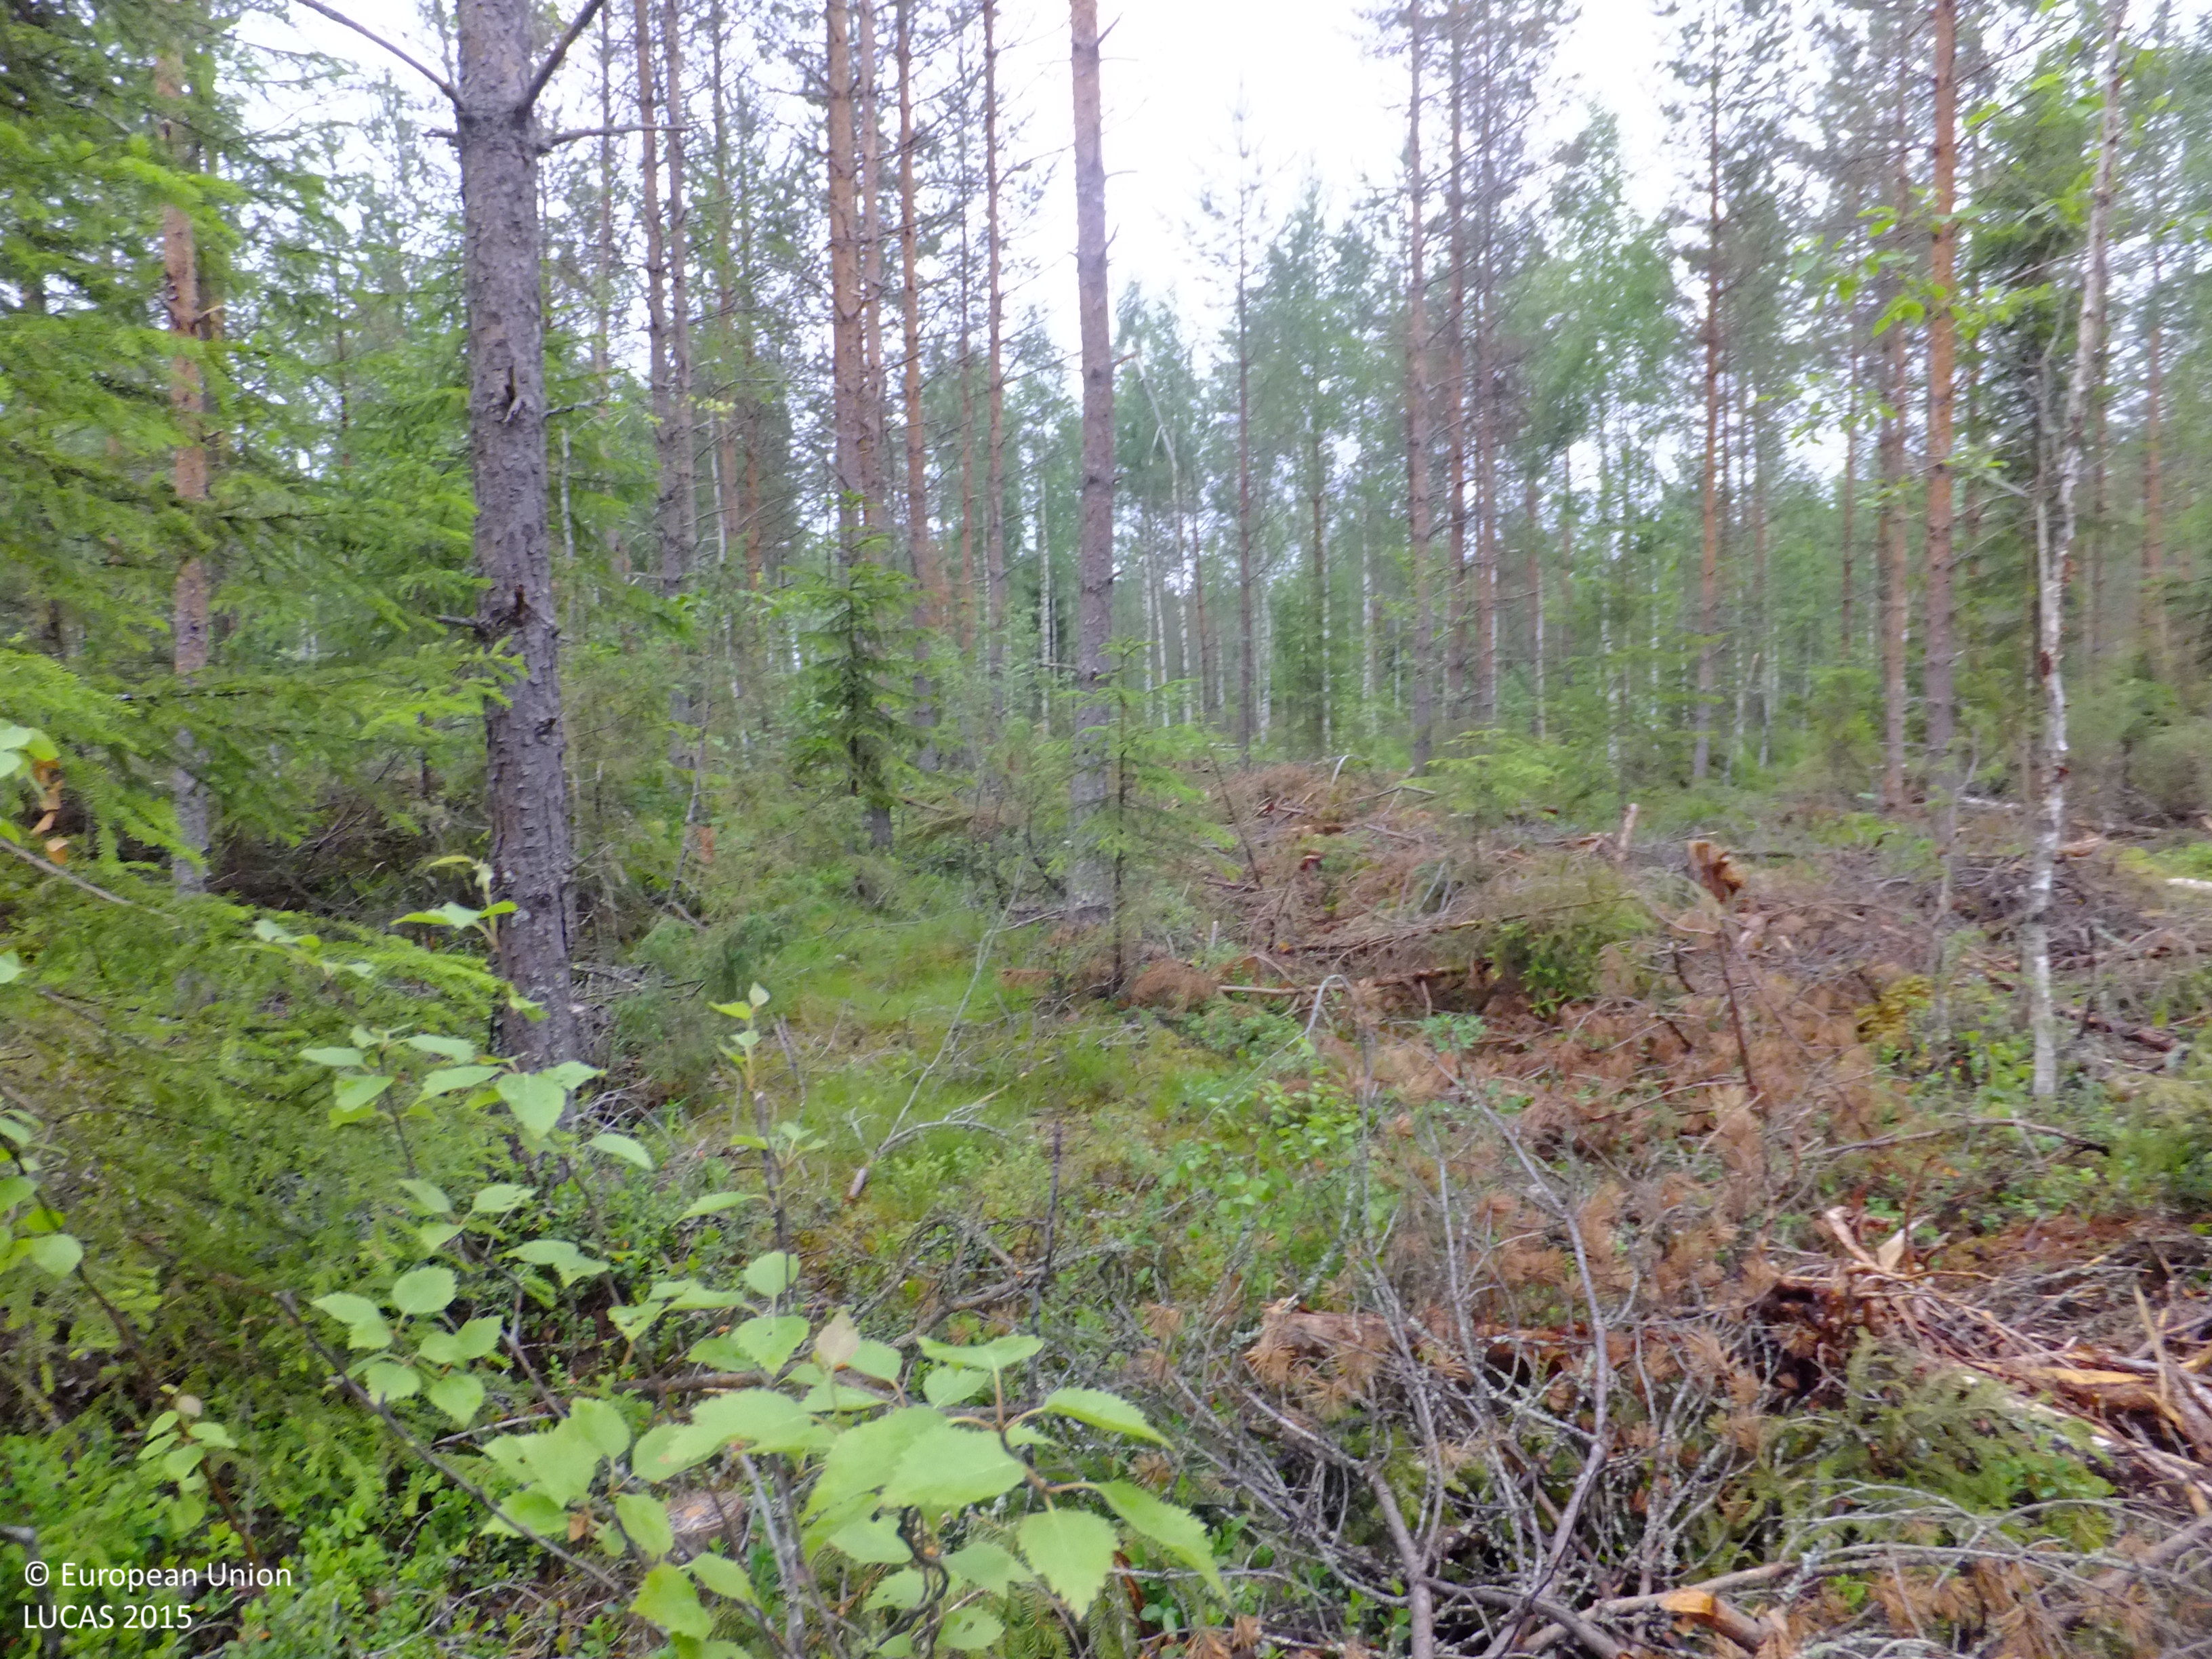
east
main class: Woodland
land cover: Other coniferous woodland
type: boreal forest
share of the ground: > 75 %
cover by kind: coniferous forest trees 70 %, broadleaved forest trees 10 %, shrubs 10 %, herbaceous plants 5 %, lichens and mosses 5 %
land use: Forestry
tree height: > 5 m
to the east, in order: Other coniferous woodland; Tracks; Broadleaved woodland; Ditches and canals; Pine dominated mixed woodland; Tracks; Other mixed woodland; Tracks; Shrubland with sparse tree cover; Paved roads, cycling and walking lanes; Grass margins; Ditches and canals; Electric lines; Pine dominated mixed woodland
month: July
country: FI
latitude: 63.1689
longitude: 24.5613
